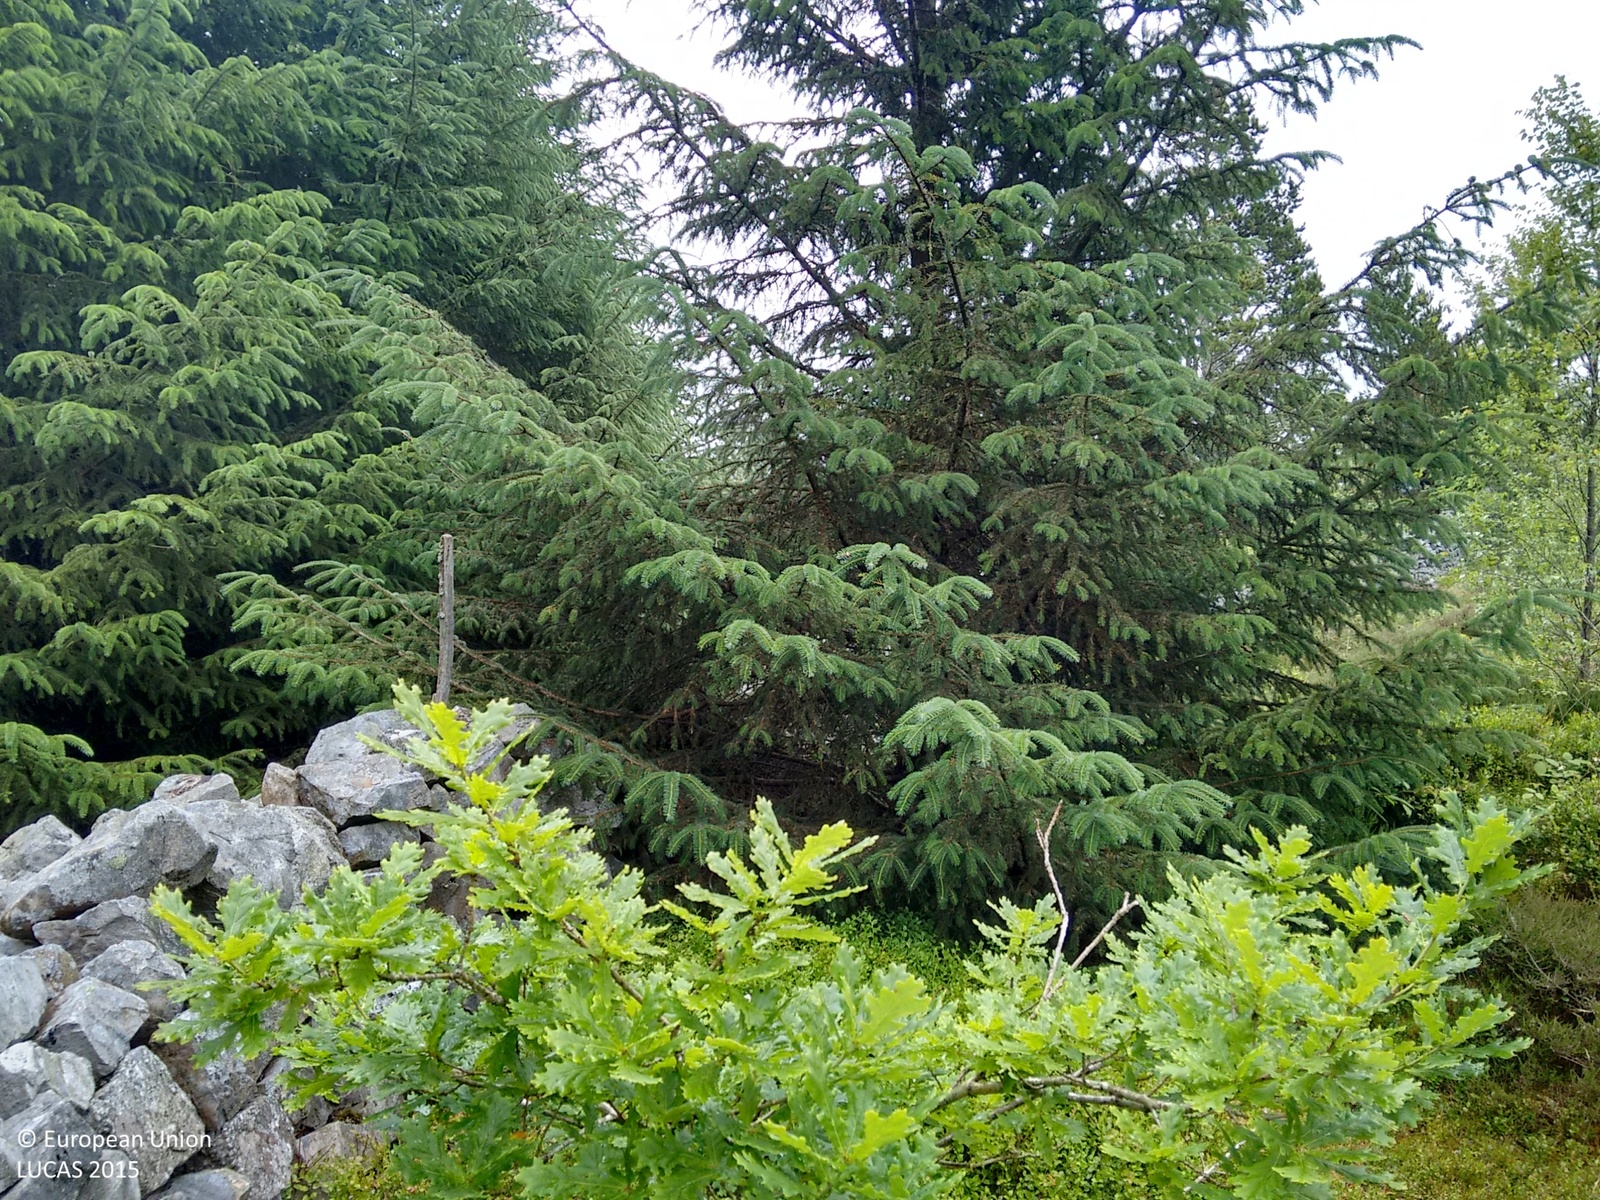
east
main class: Woodland
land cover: Spruce dominated coniferous woodland
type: exotic forest
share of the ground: > 75 %
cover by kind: coniferous forest trees 90 %, shrubs 10 %
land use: Forestry
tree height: > 5 m
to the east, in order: Spruce dominated coniferous woodland; Grassland with sparse tree/shrub cover; Broadleaved woodland
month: July
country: GB
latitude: 51.7738
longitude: -3.4310
